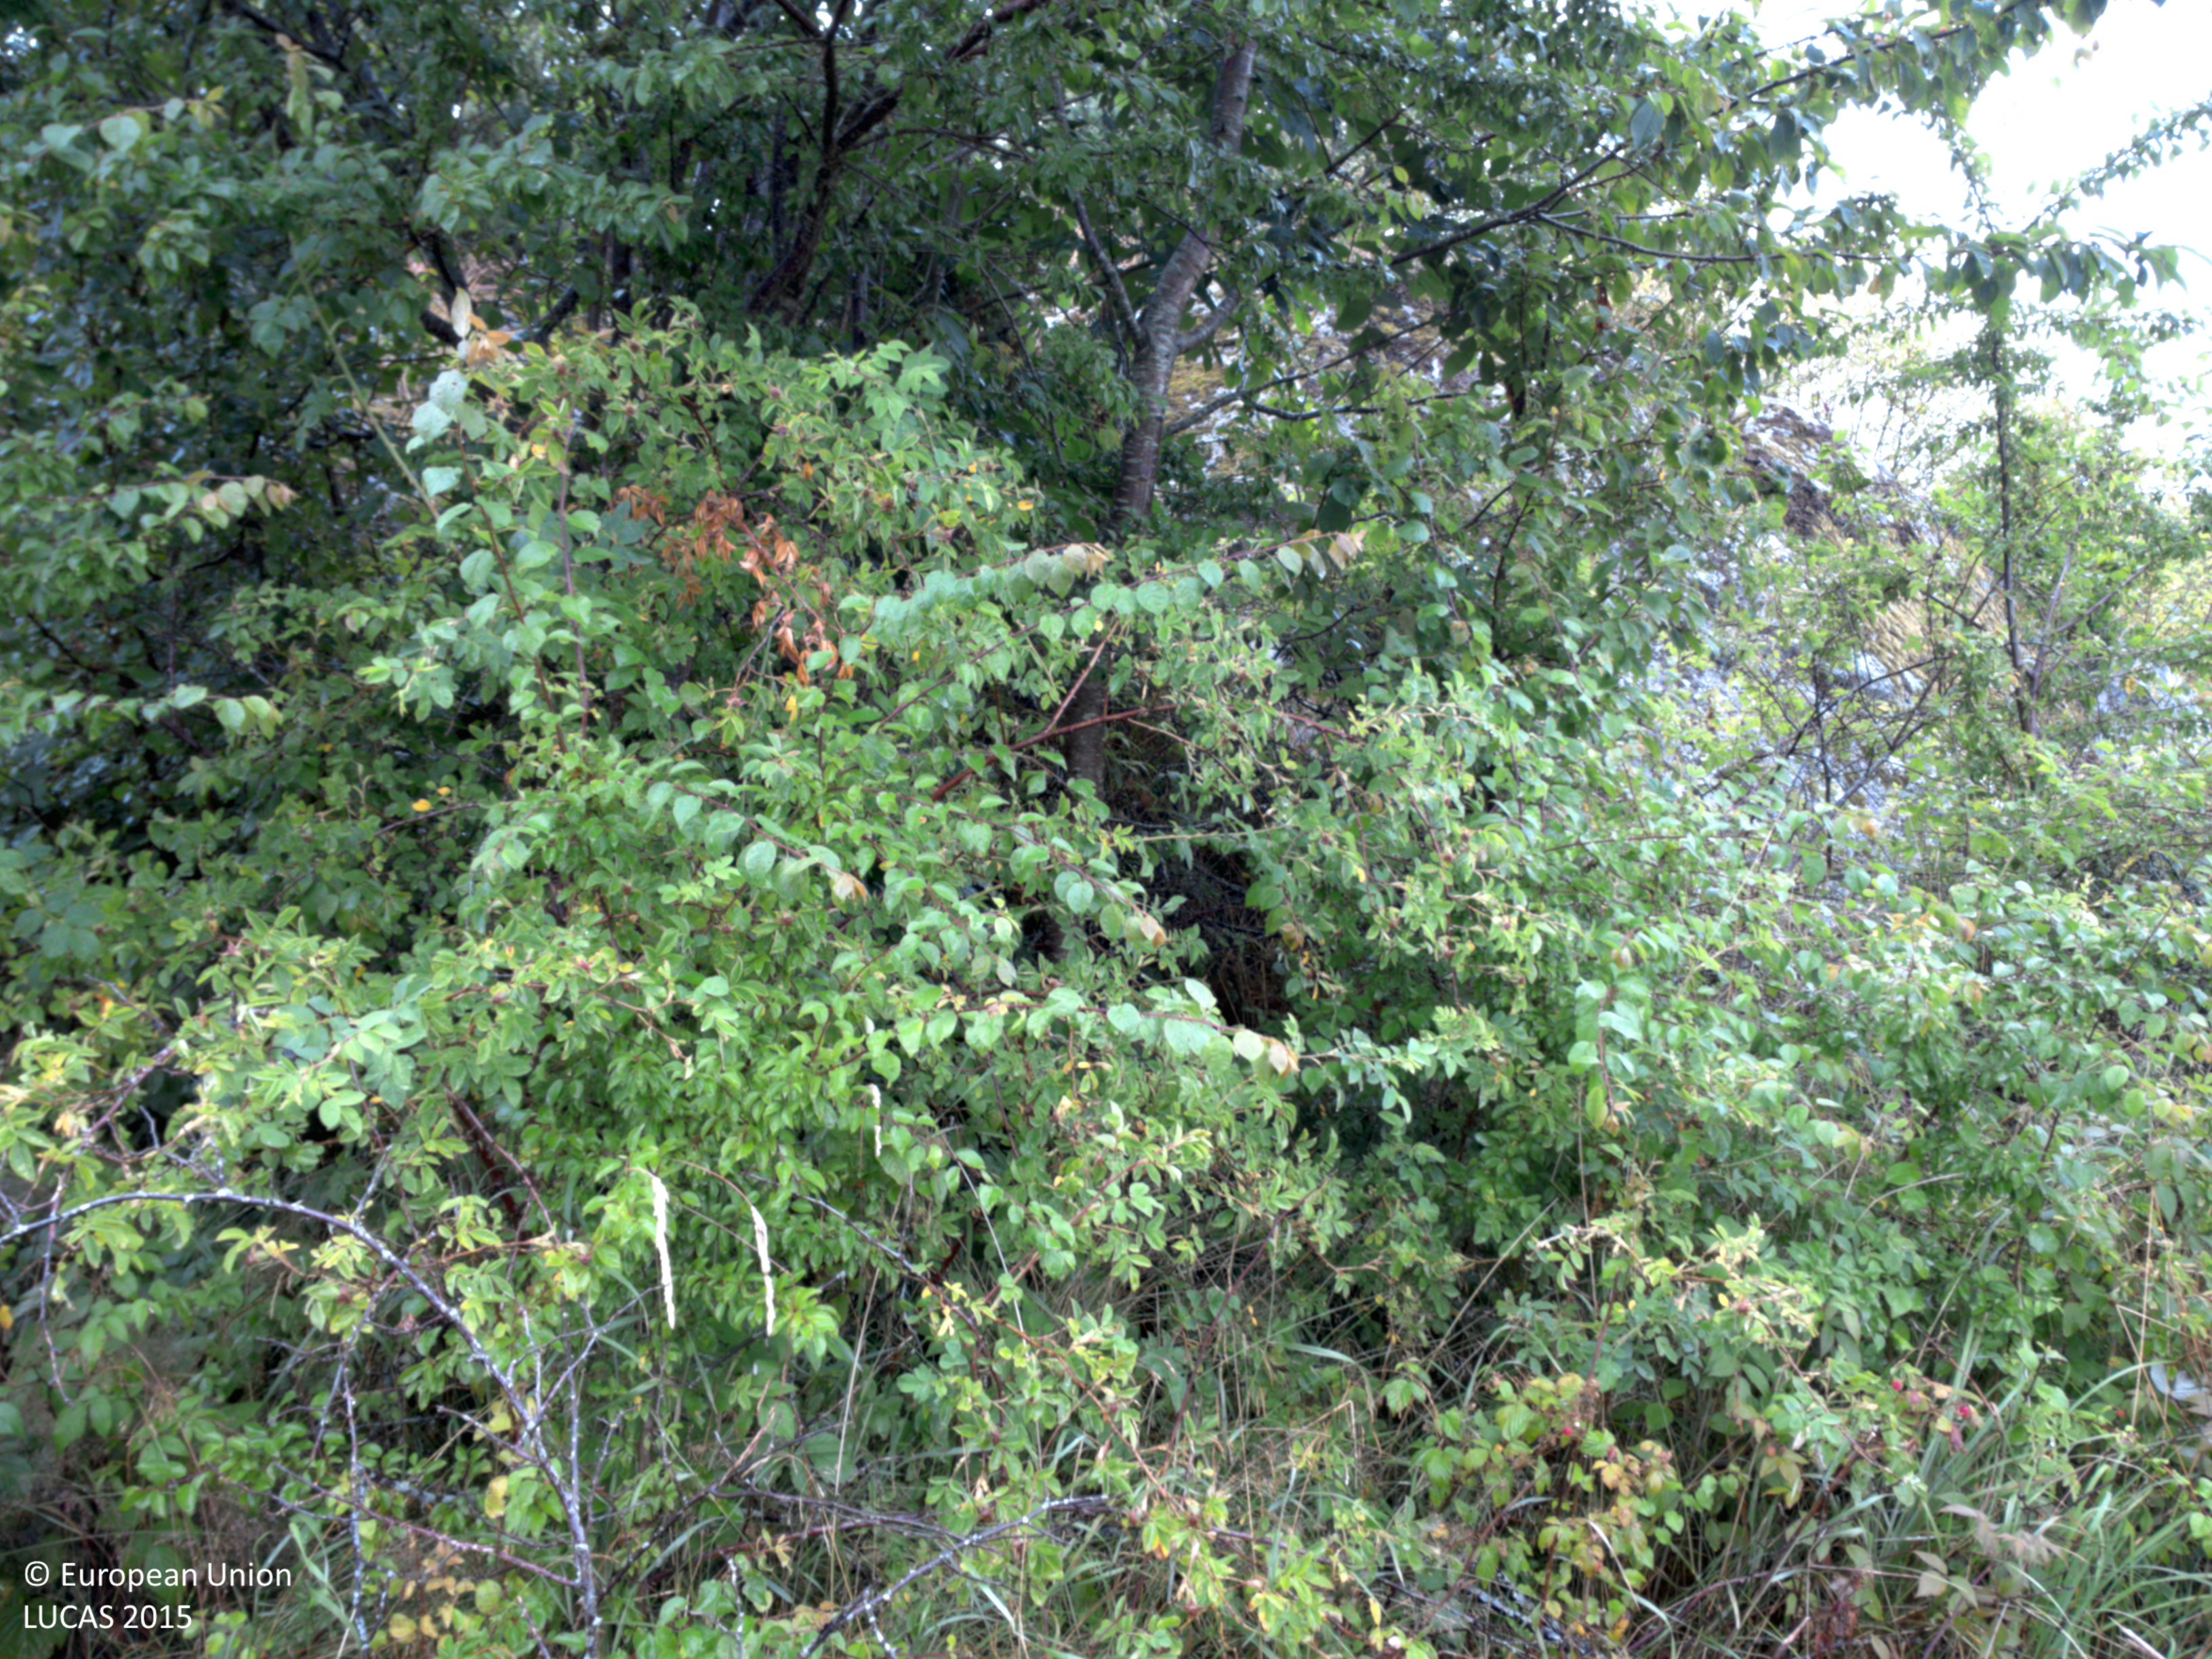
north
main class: Grassland
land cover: Grassland without tree/shrub cover
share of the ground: > 75 %
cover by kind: herbaceous plants 95 %, shrubs 5 %
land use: Abandoned areas
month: July
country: SE
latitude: 58.2947
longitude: 11.9921
